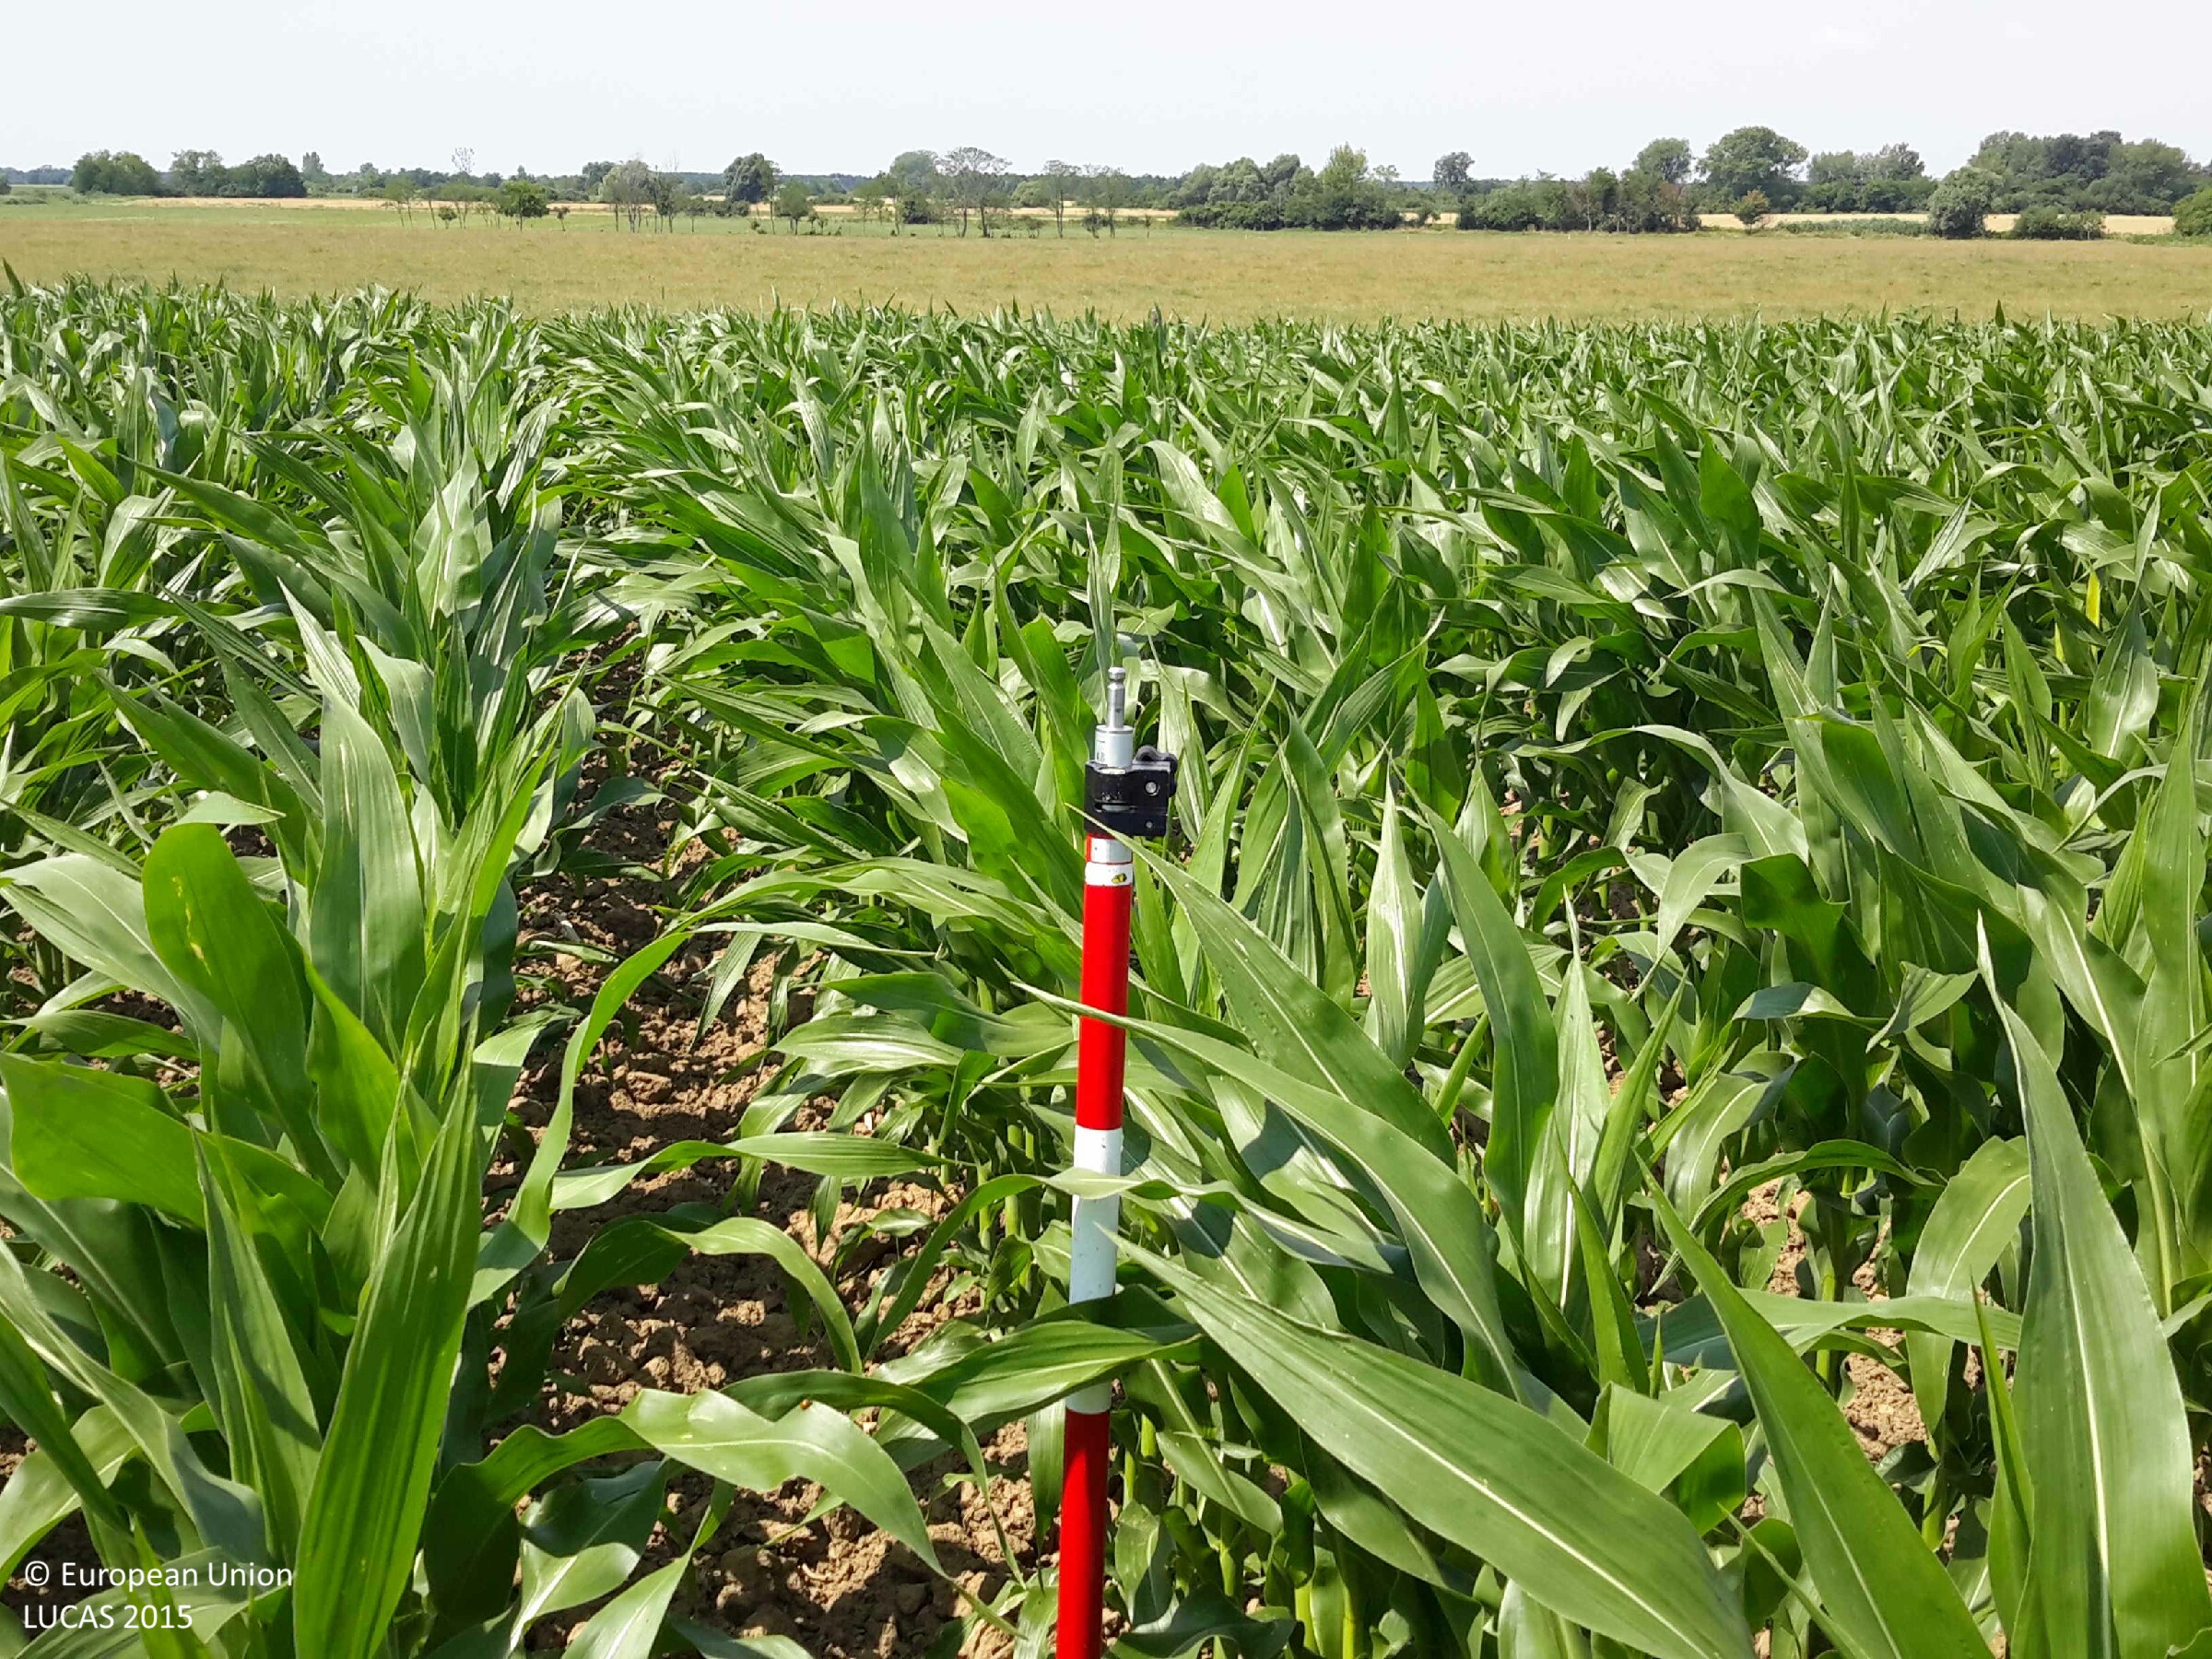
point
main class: Cropland
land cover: Maize
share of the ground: 50 - 75 %
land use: Agriculture (excluding fallow land and kitchen gardens)
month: June
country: HU
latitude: 47.2666
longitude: 17.4482
